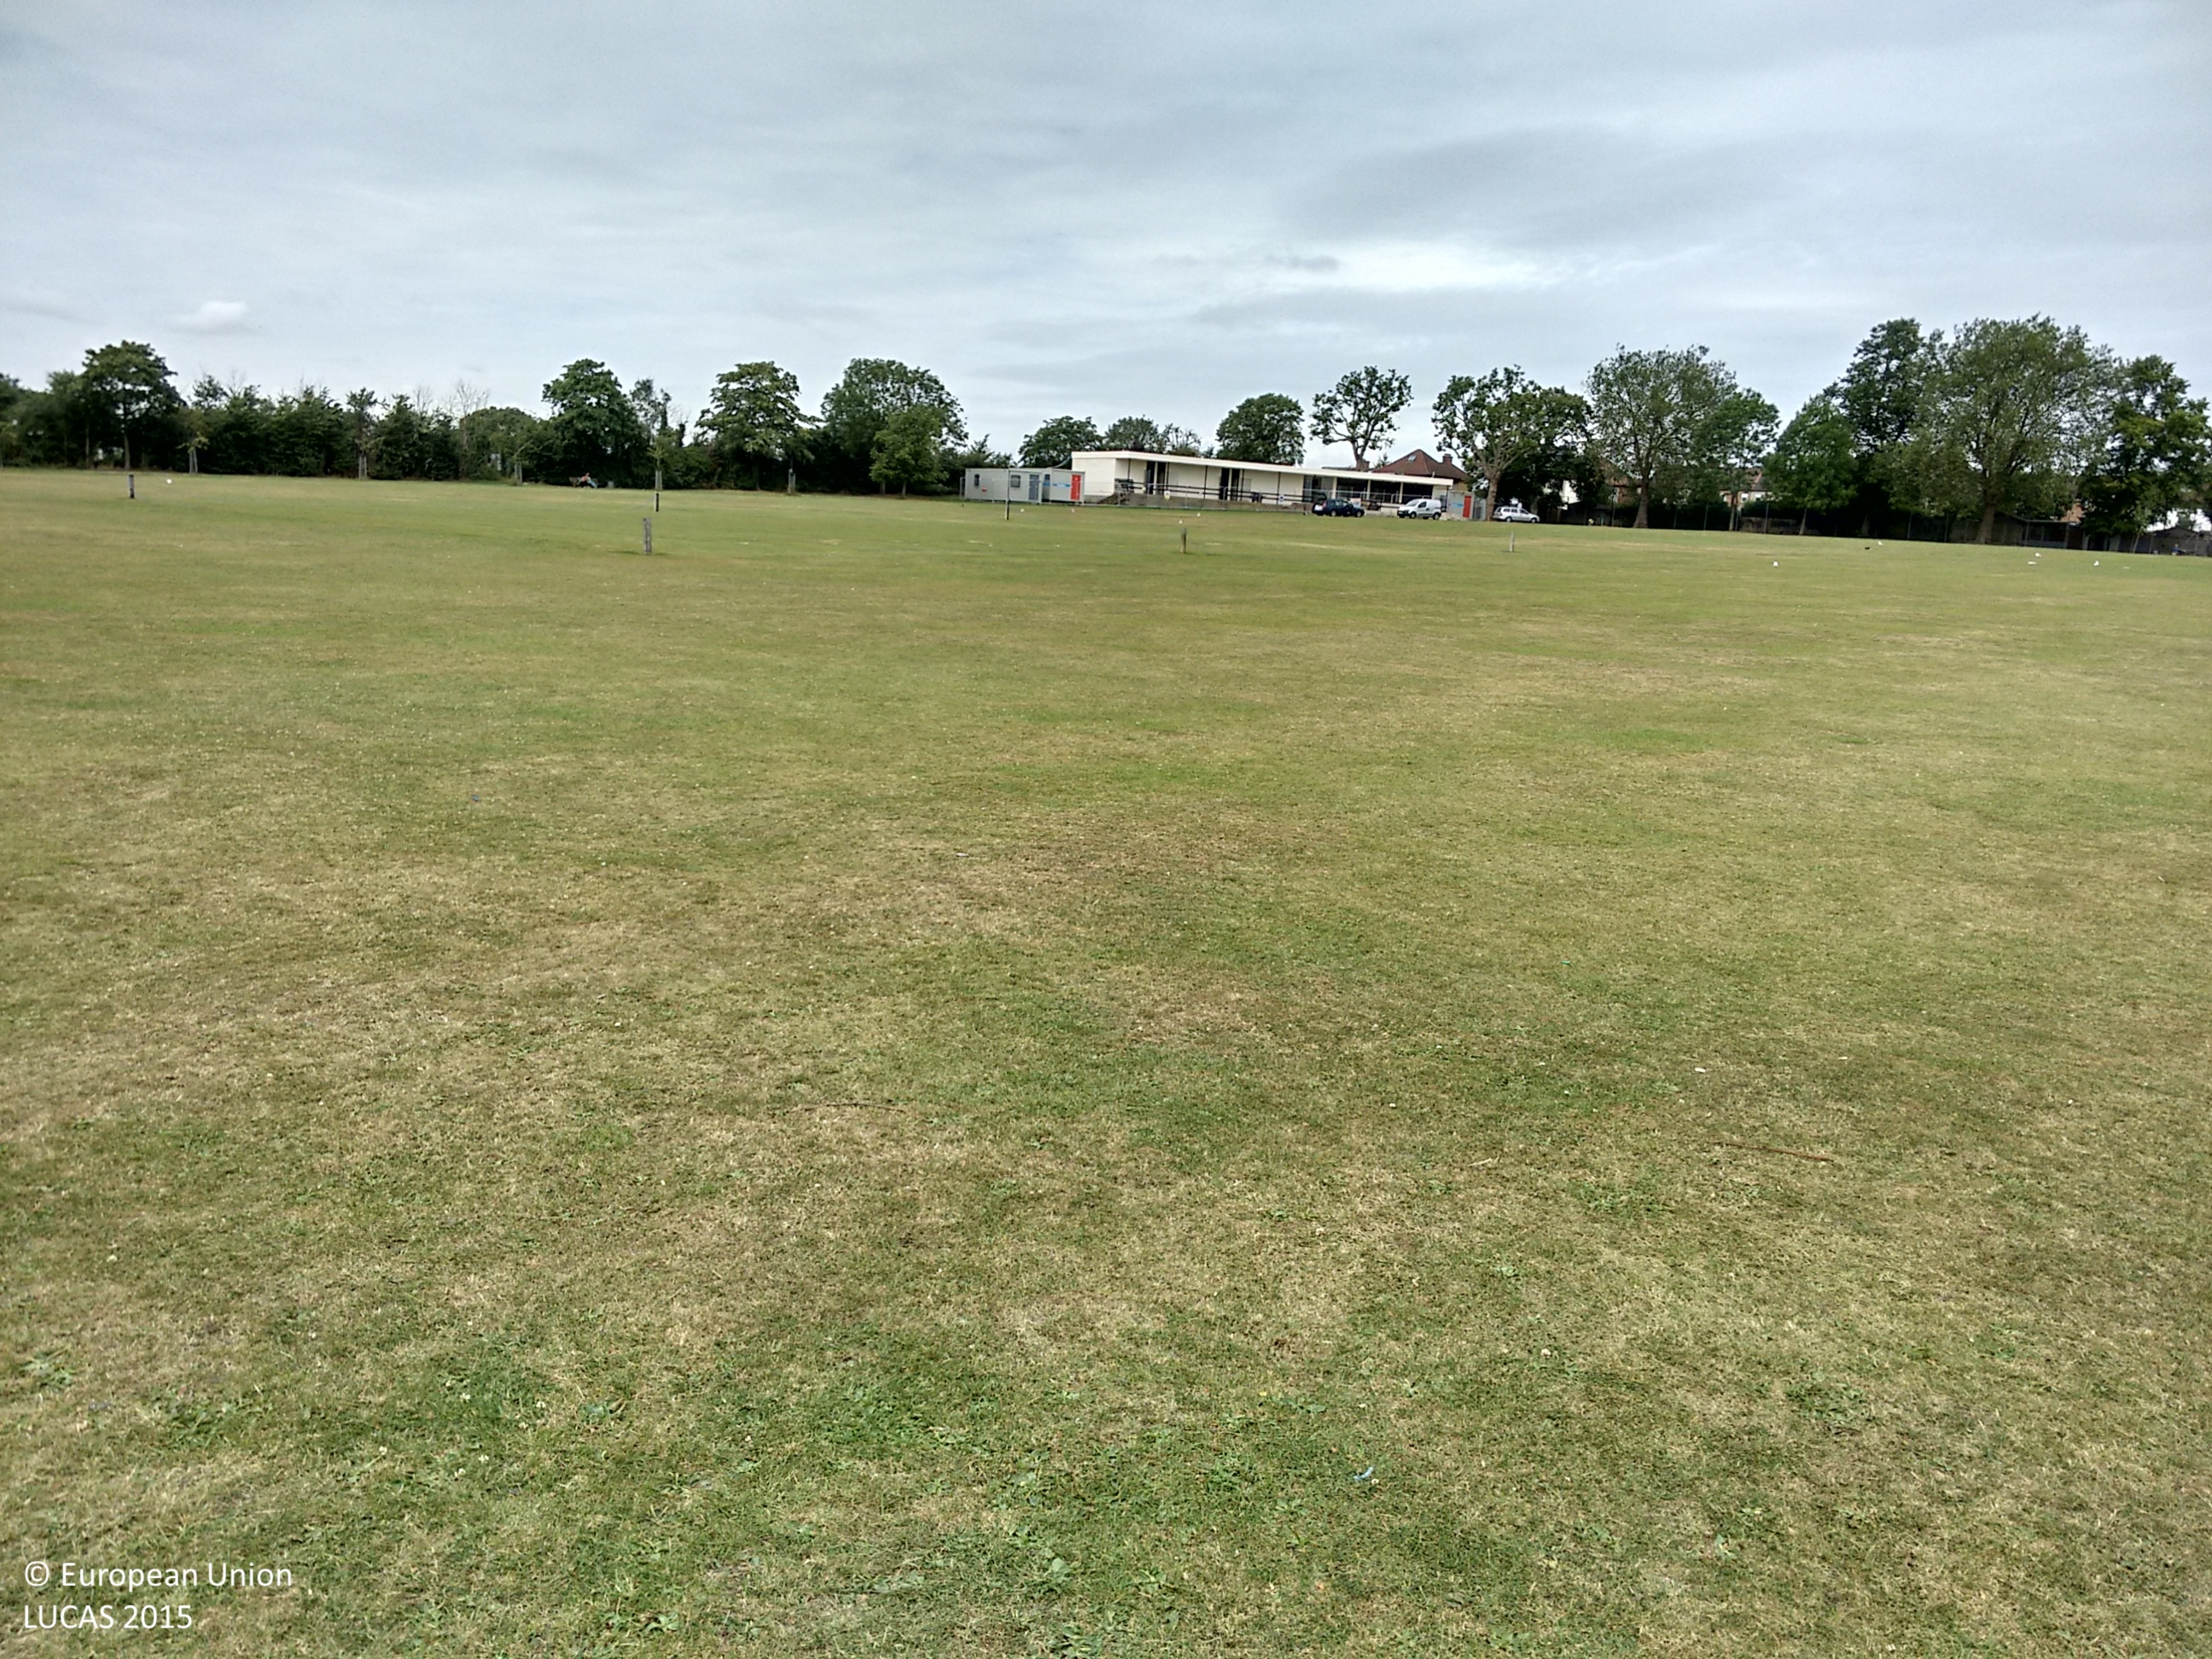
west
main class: Grassland
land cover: Grassland without tree/shrub cover
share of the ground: > 75 %
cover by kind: herbaceous plants 100 %
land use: Amenities, museums, leisure
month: July
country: GB
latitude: 51.5612
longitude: -0.3505
